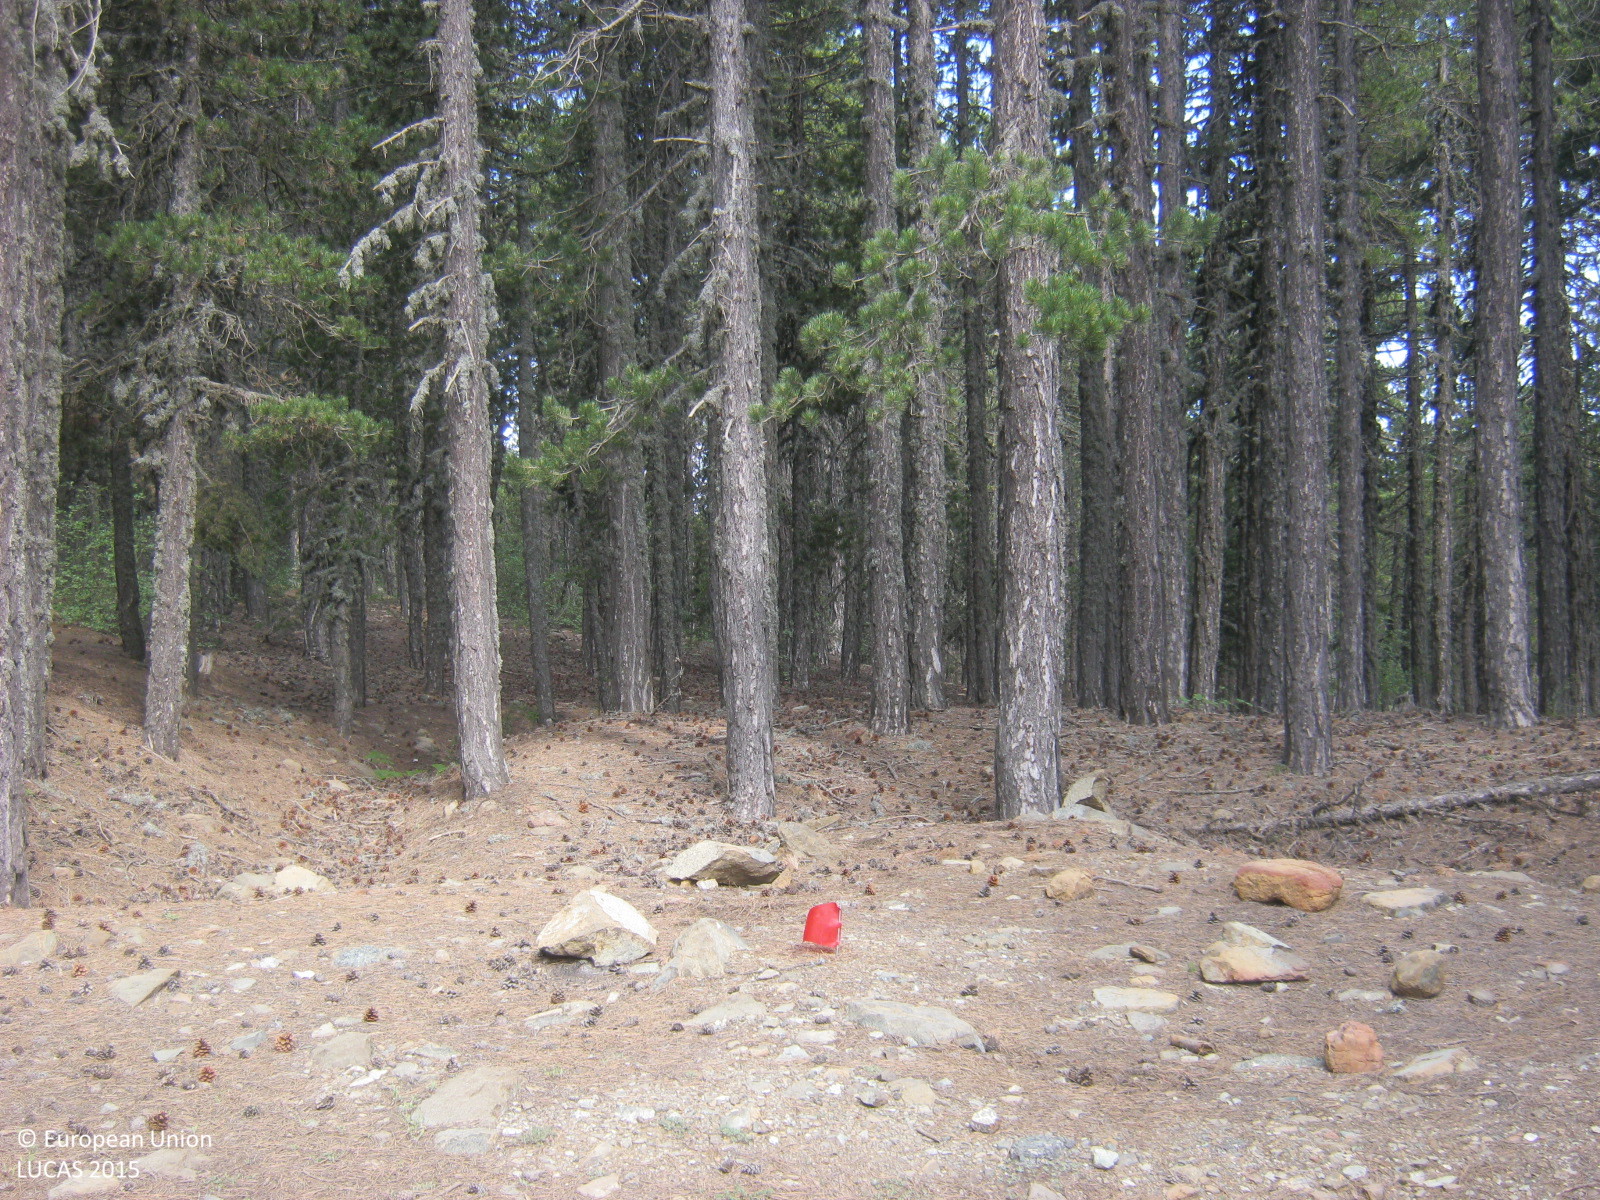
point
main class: Woodland
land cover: Pine dominated coniferous woodland
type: coniferous forest of the mediterranean region
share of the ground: > 75 %
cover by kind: coniferous forest trees 80 %, unconsolidated bare surface 15 %, shrubs 5 %
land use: Forestry
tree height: > 5 m
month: June
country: CY
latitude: 34.9412
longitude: 32.8638
